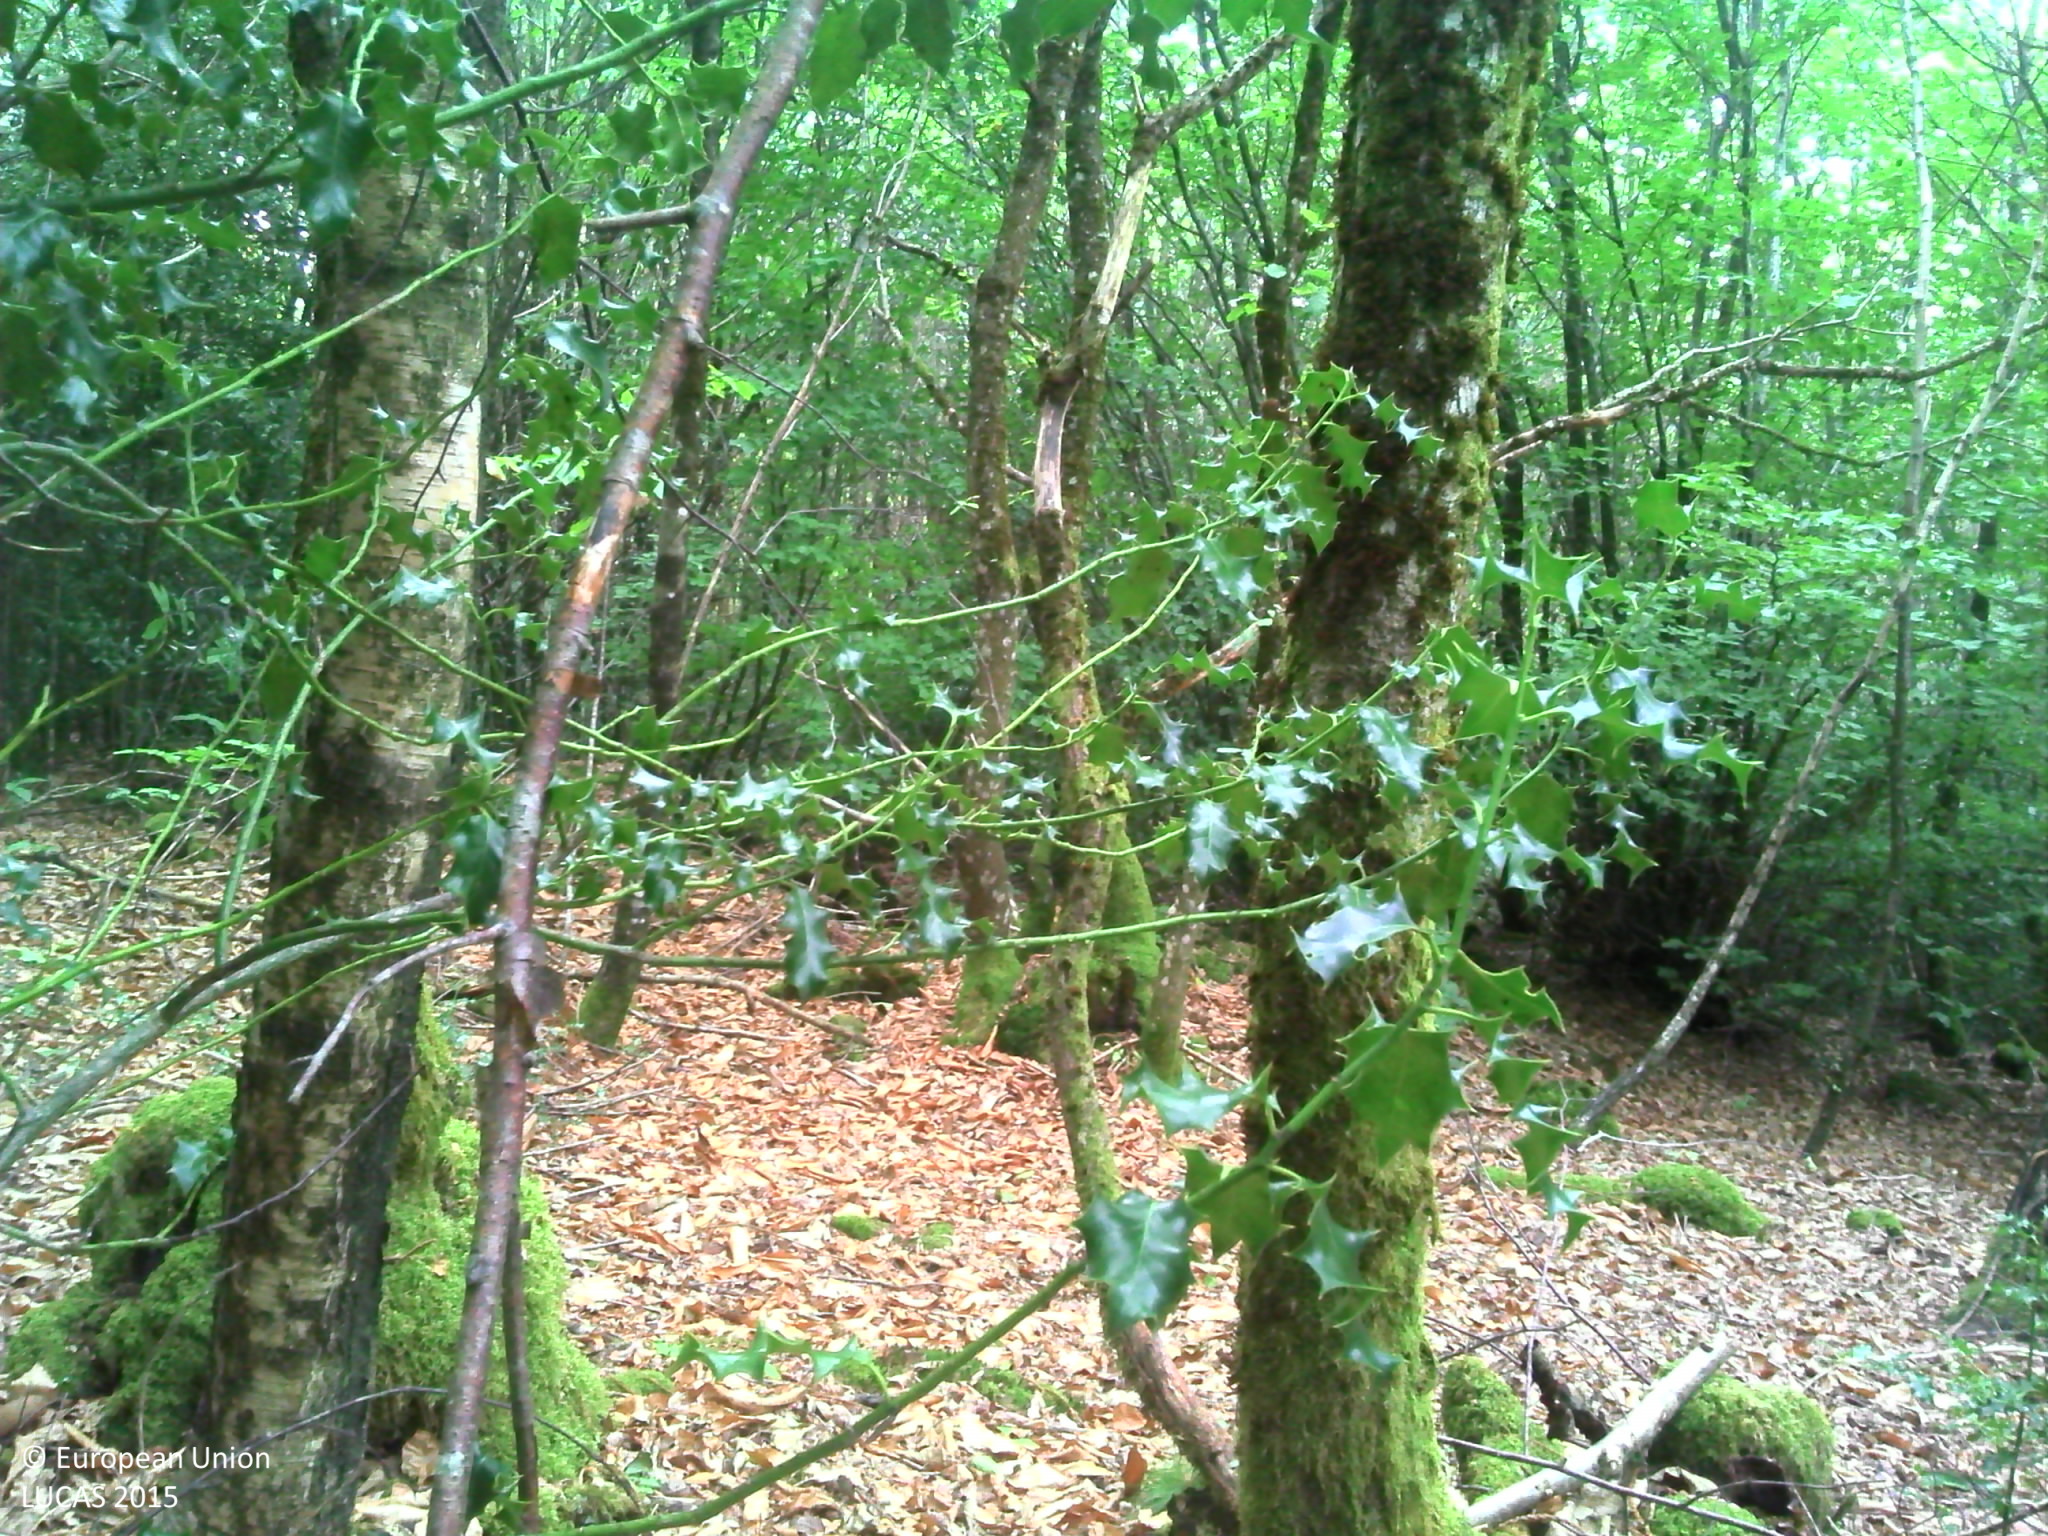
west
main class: Woodland
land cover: Broadleaved woodland
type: acidophilous oak and oak-birch forest
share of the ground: > 75 %
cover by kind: broadleaved forest trees 100 %
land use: Semi-natural and natural areas not in use
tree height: > 5 m
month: August
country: FR
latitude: 45.8938
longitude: 1.6027
